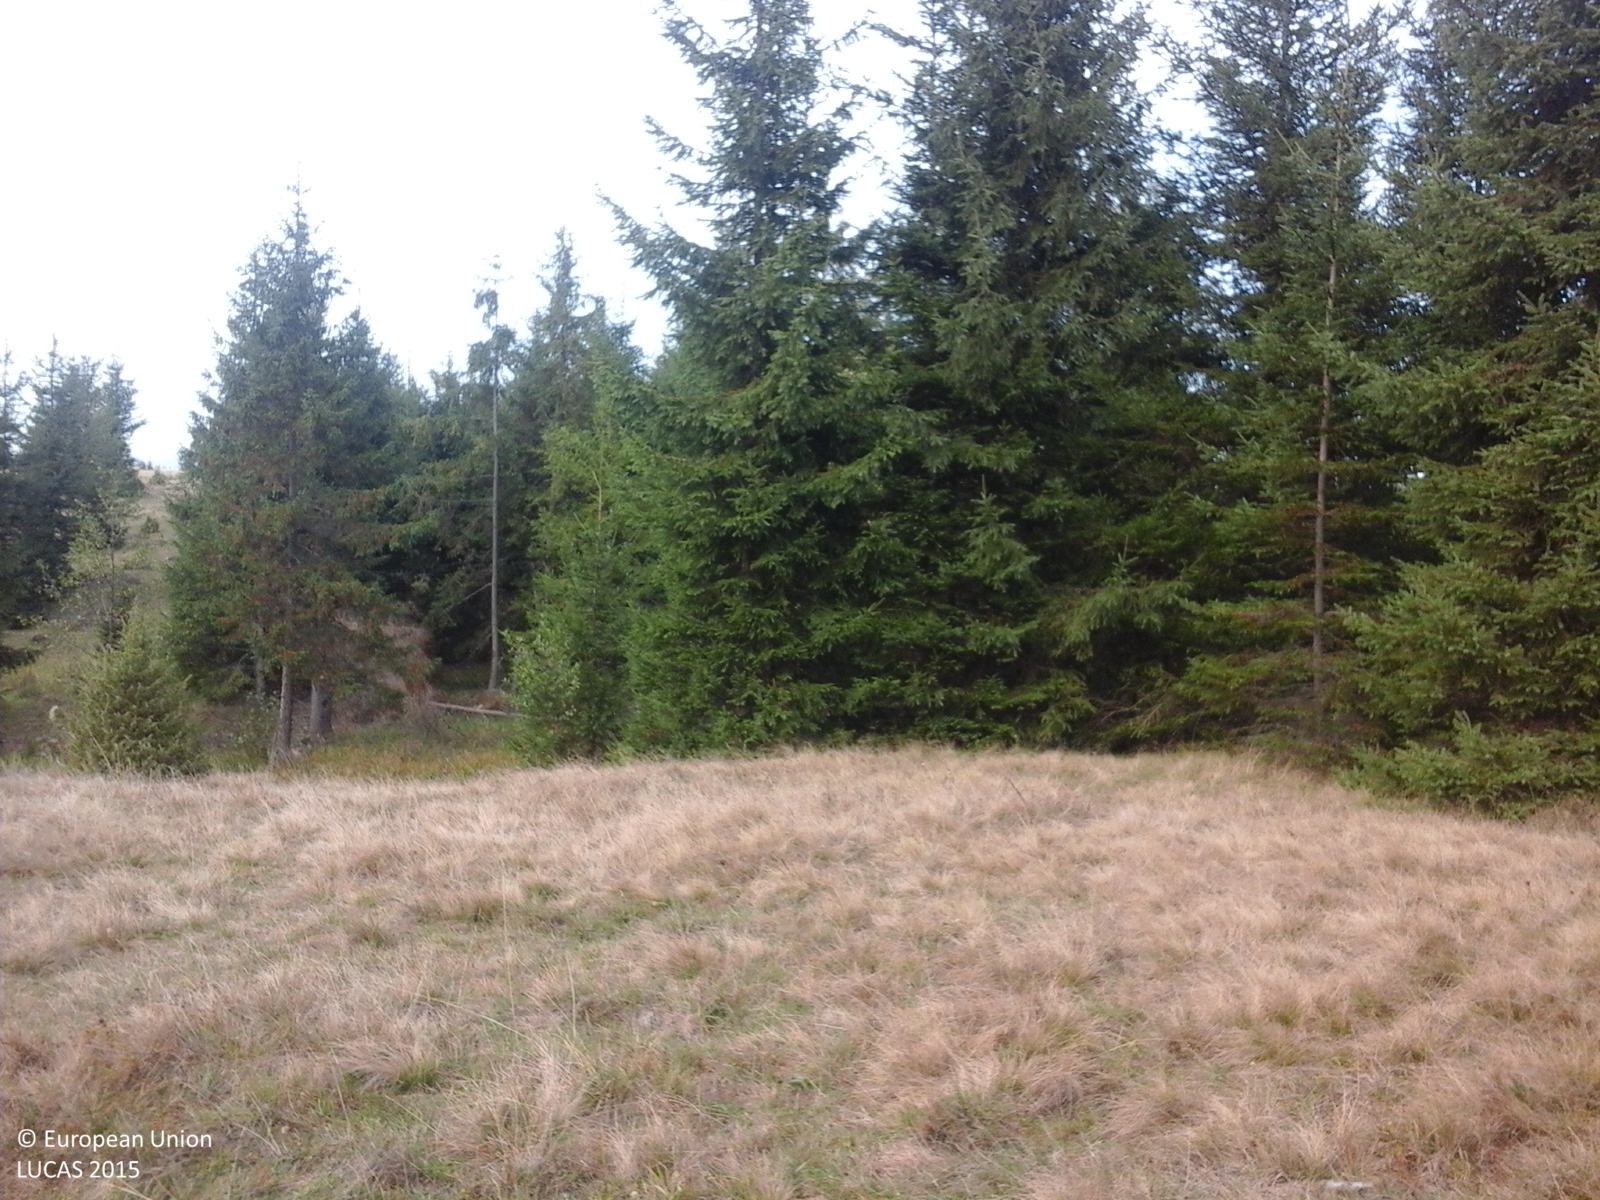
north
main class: Grassland
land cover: Grassland with sparse tree/shrub cover
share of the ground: > 75 %
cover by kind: herbaceous plants 85 %, shrubs 10 %, broadleaved forest trees 5 %
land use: Fallow land
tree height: < 5 m
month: October
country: RO
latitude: 46.3907
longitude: 25.4652
